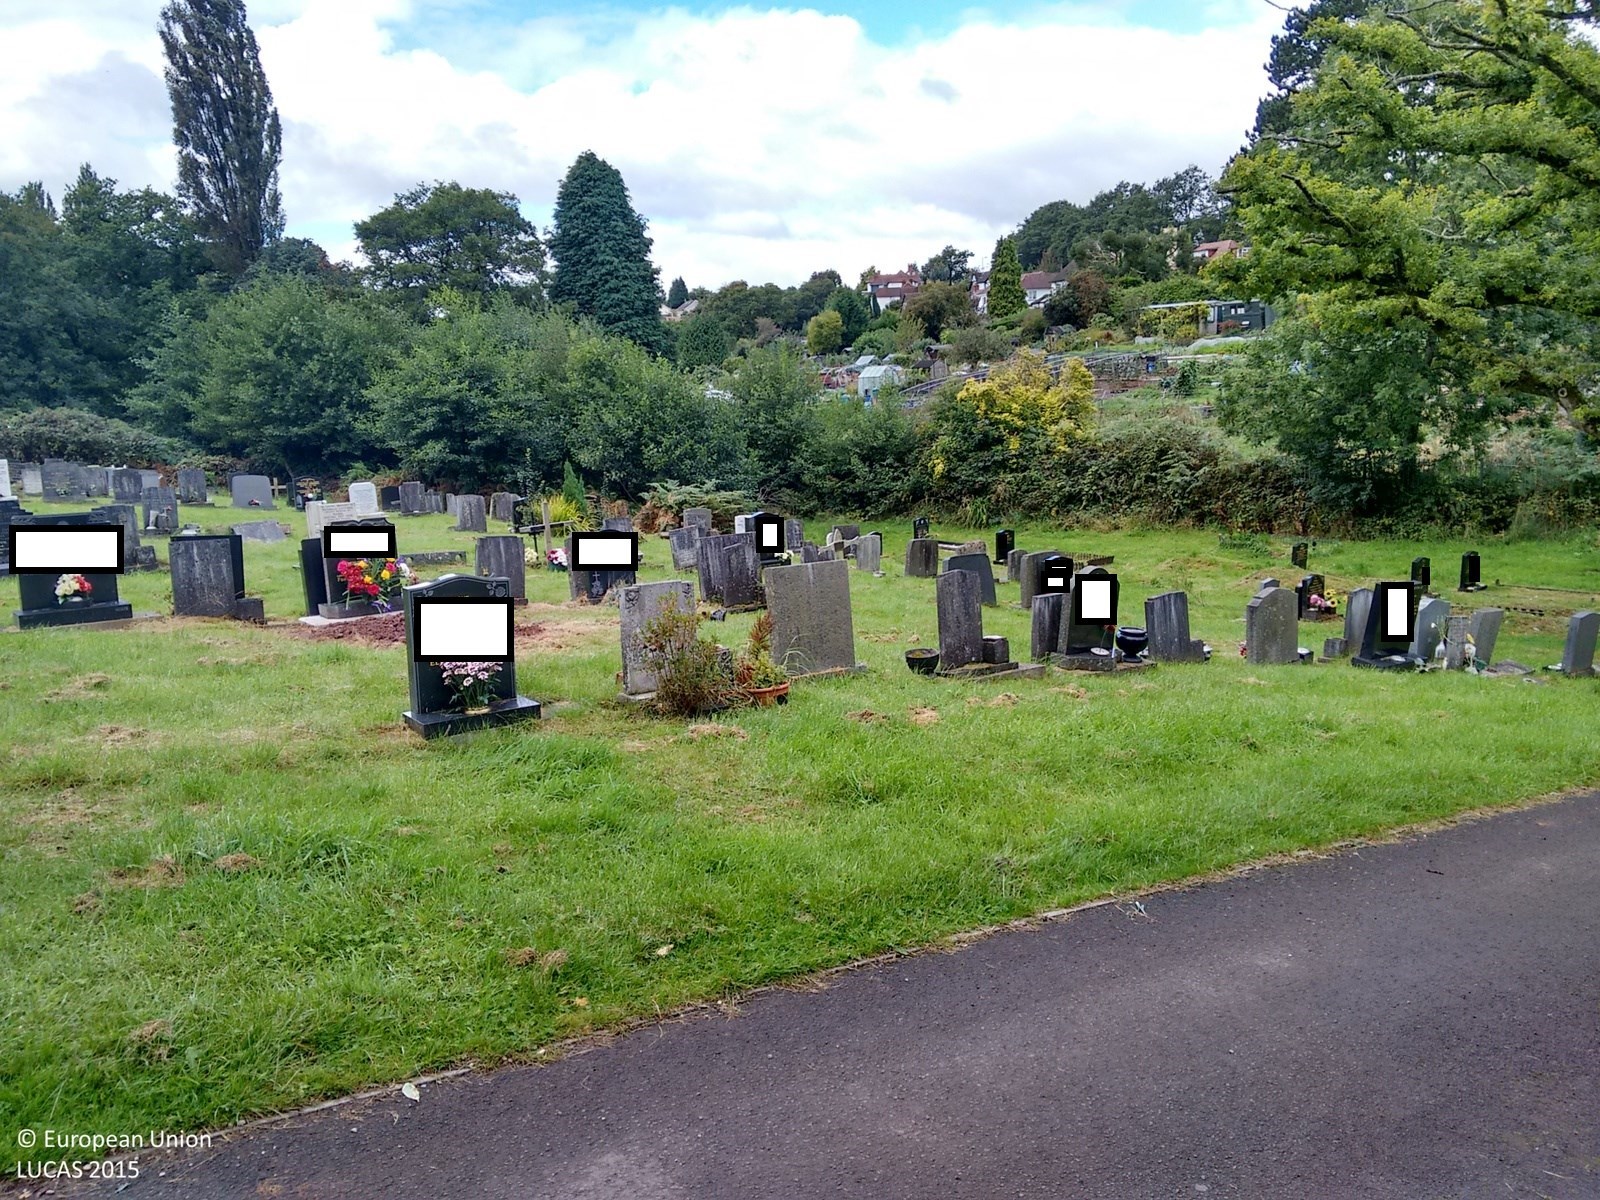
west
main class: Grassland
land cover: Grassland without tree/shrub cover
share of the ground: > 75 %
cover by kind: herbaceous plants 100 %
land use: Community services
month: September
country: GB
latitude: 51.5835
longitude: -3.0210
